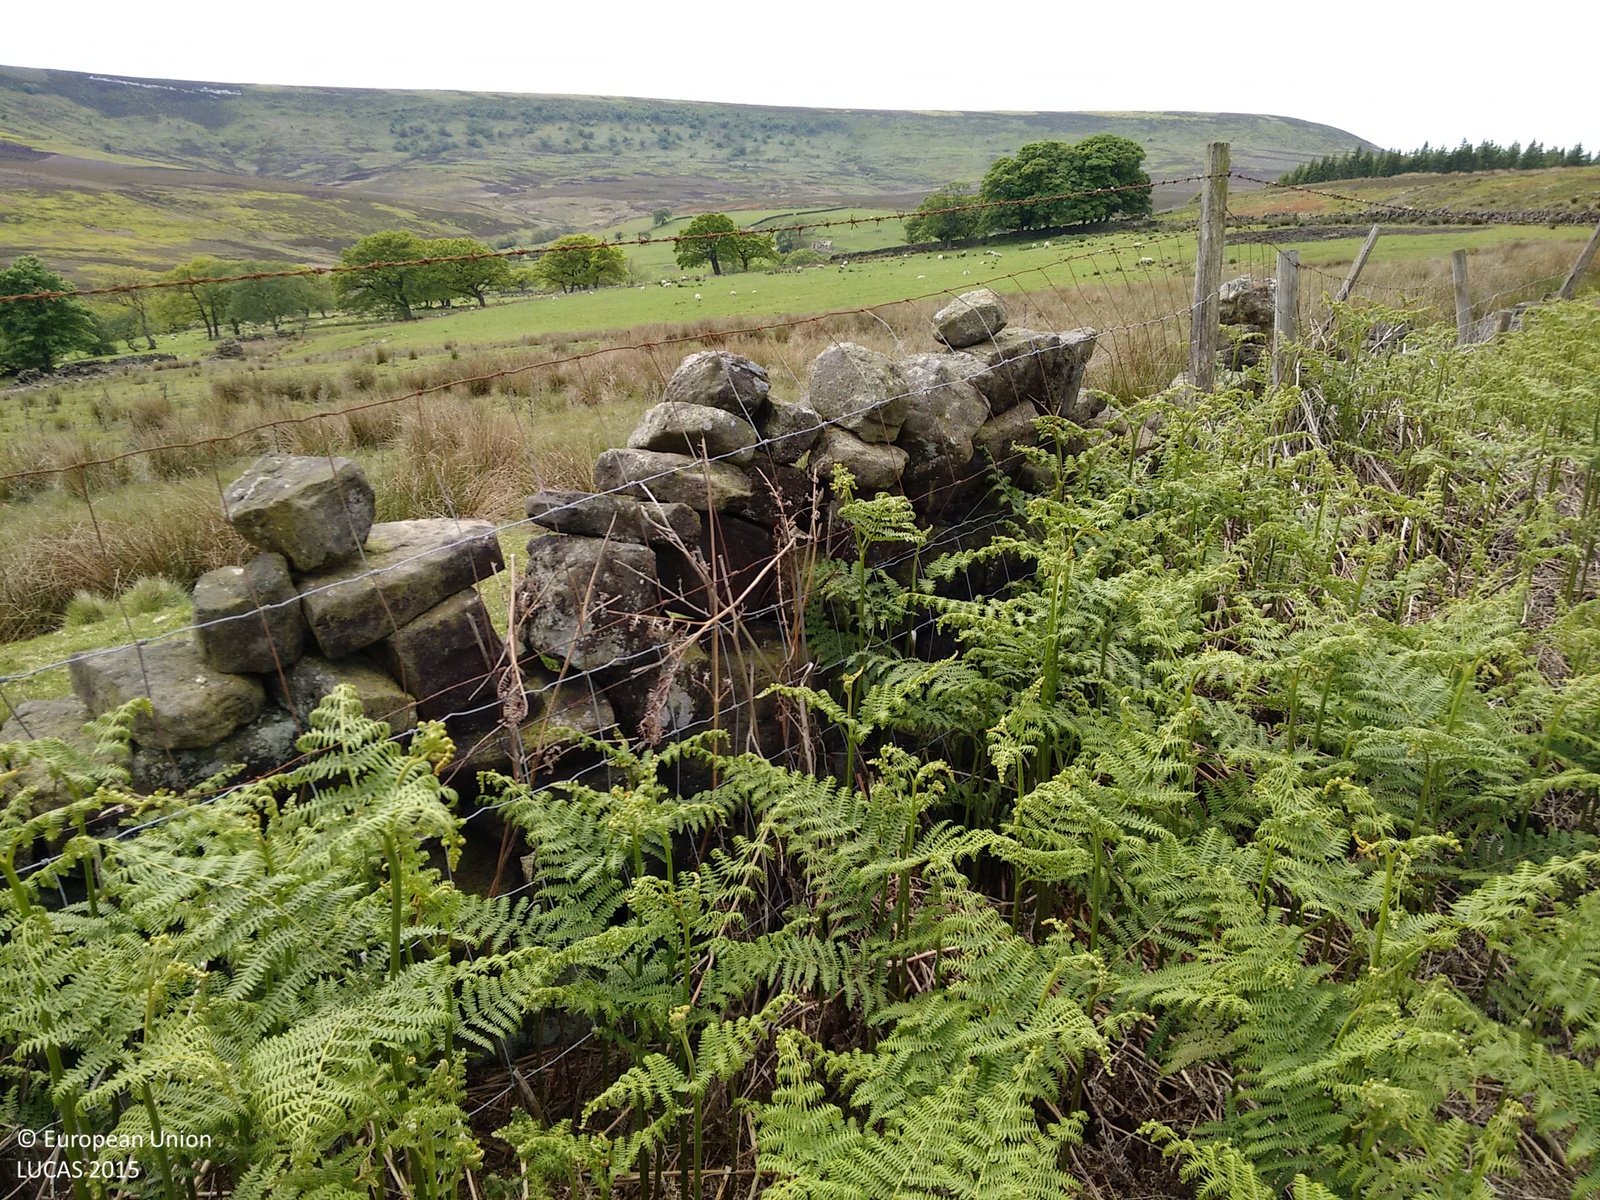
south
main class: Grassland
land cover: Grassland without tree/shrub cover
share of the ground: > 75 %
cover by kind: herbaceous plants 100 %
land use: Agriculture (excluding fallow land and kitchen gardens)
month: June
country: GB
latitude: 54.3488
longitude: -1.2297
